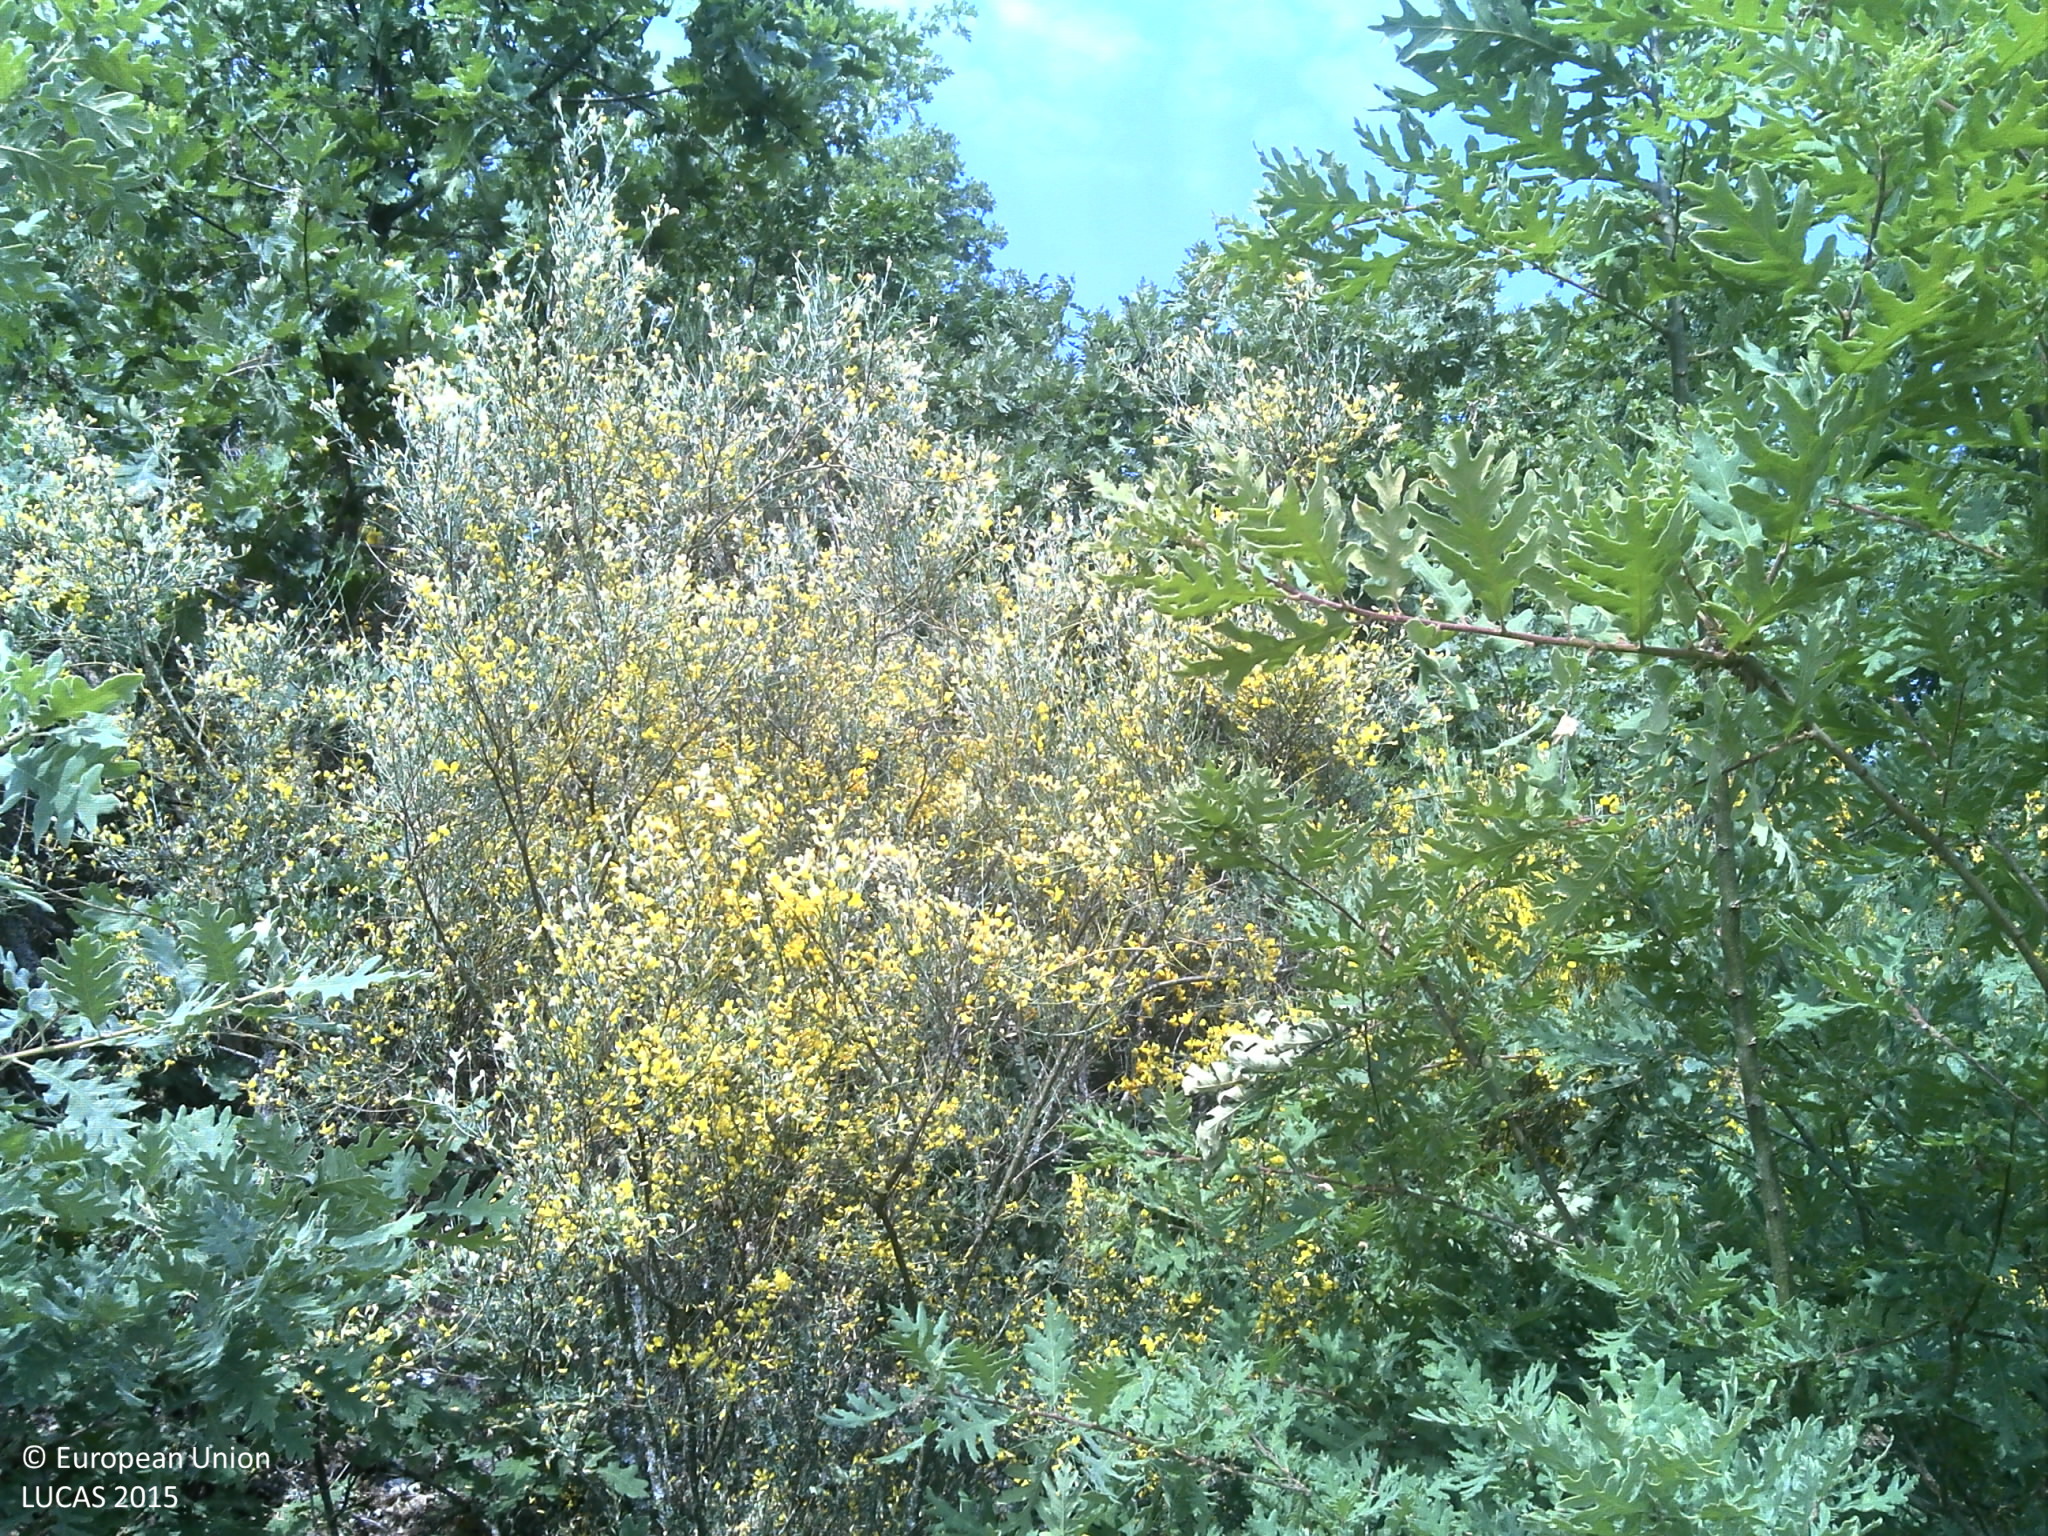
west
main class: Woodland
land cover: Broadleaved woodland
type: acidophilous oak and oak-birch forest
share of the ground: 25 - 50 %
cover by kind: shrubs 75 %, broadleaved forest trees 25 %
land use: Forestry
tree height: > 5 m
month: June
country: PT
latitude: 41.8047
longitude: -6.6111
